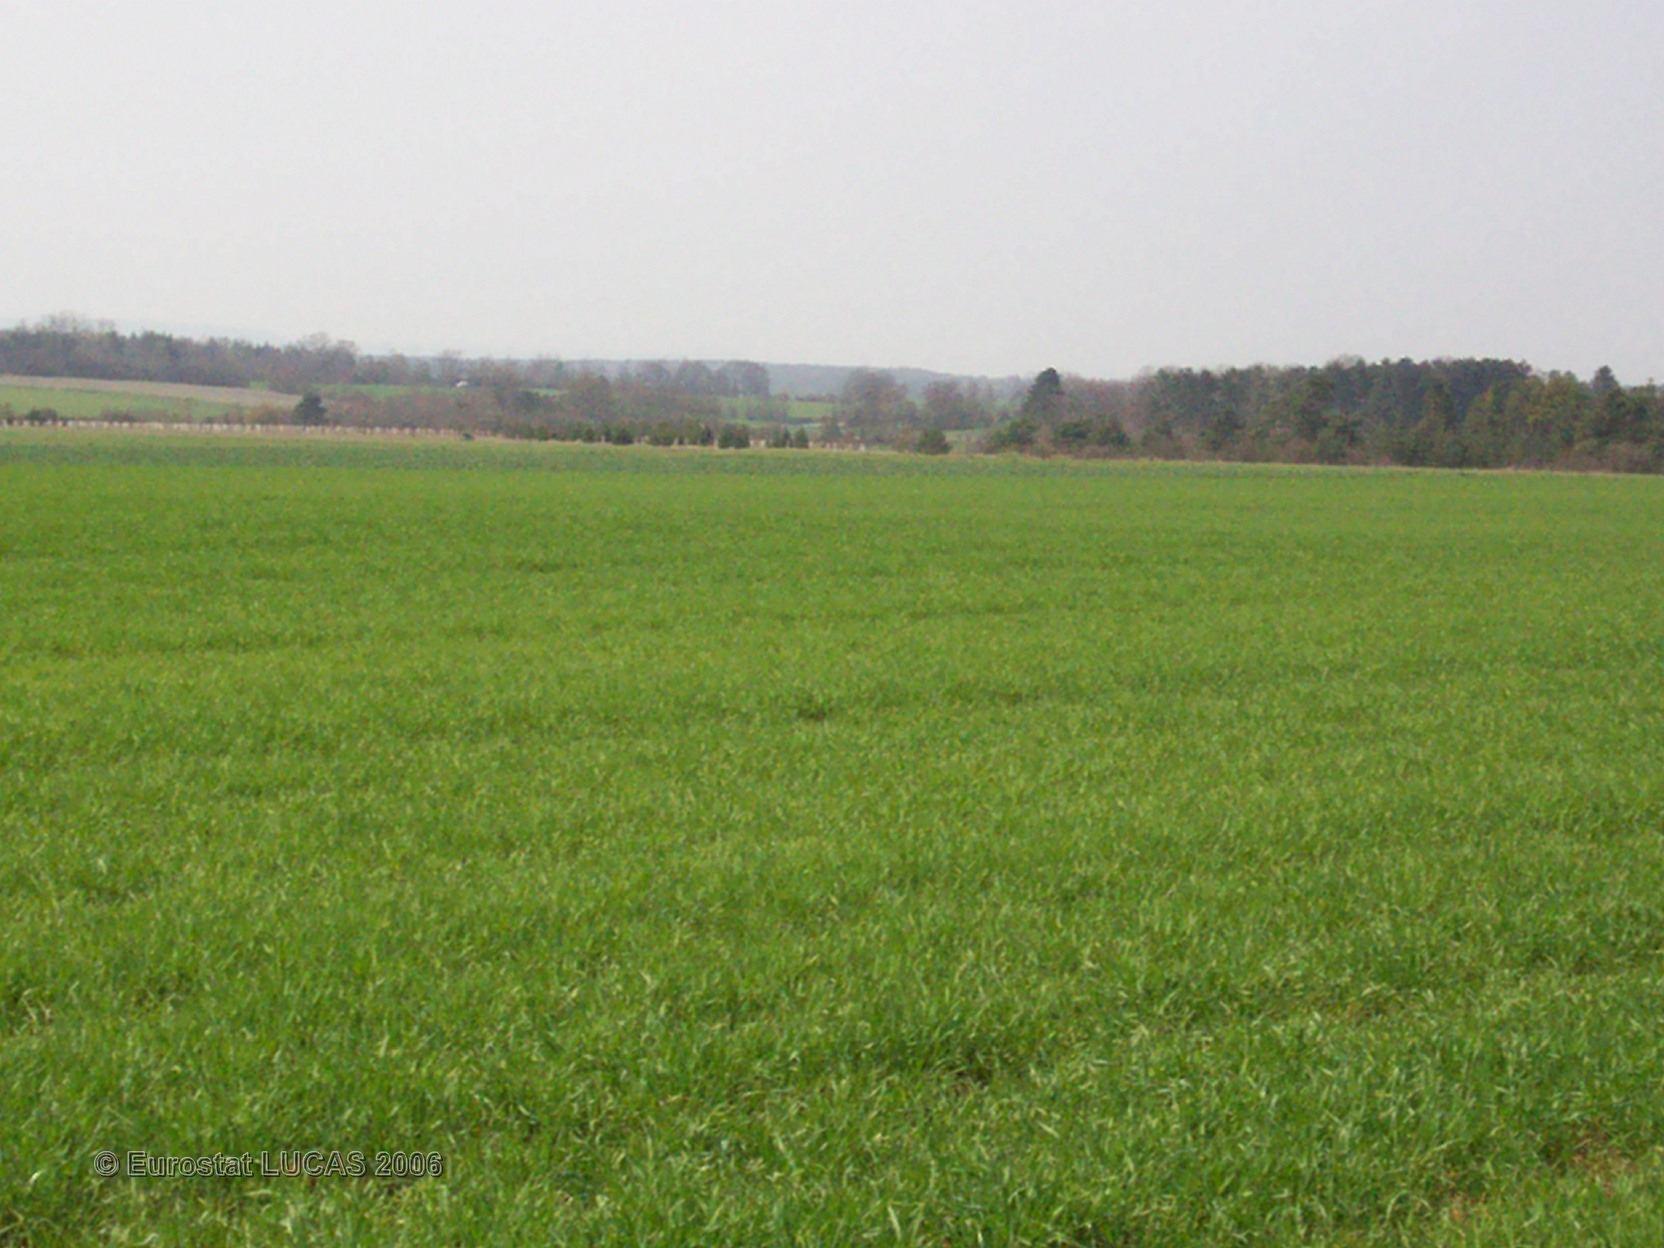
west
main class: Cropland
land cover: Barley
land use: Agriculture (excluding fallow land and kitchen gardens)
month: April
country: FR
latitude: 48.7441
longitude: 5.9608
